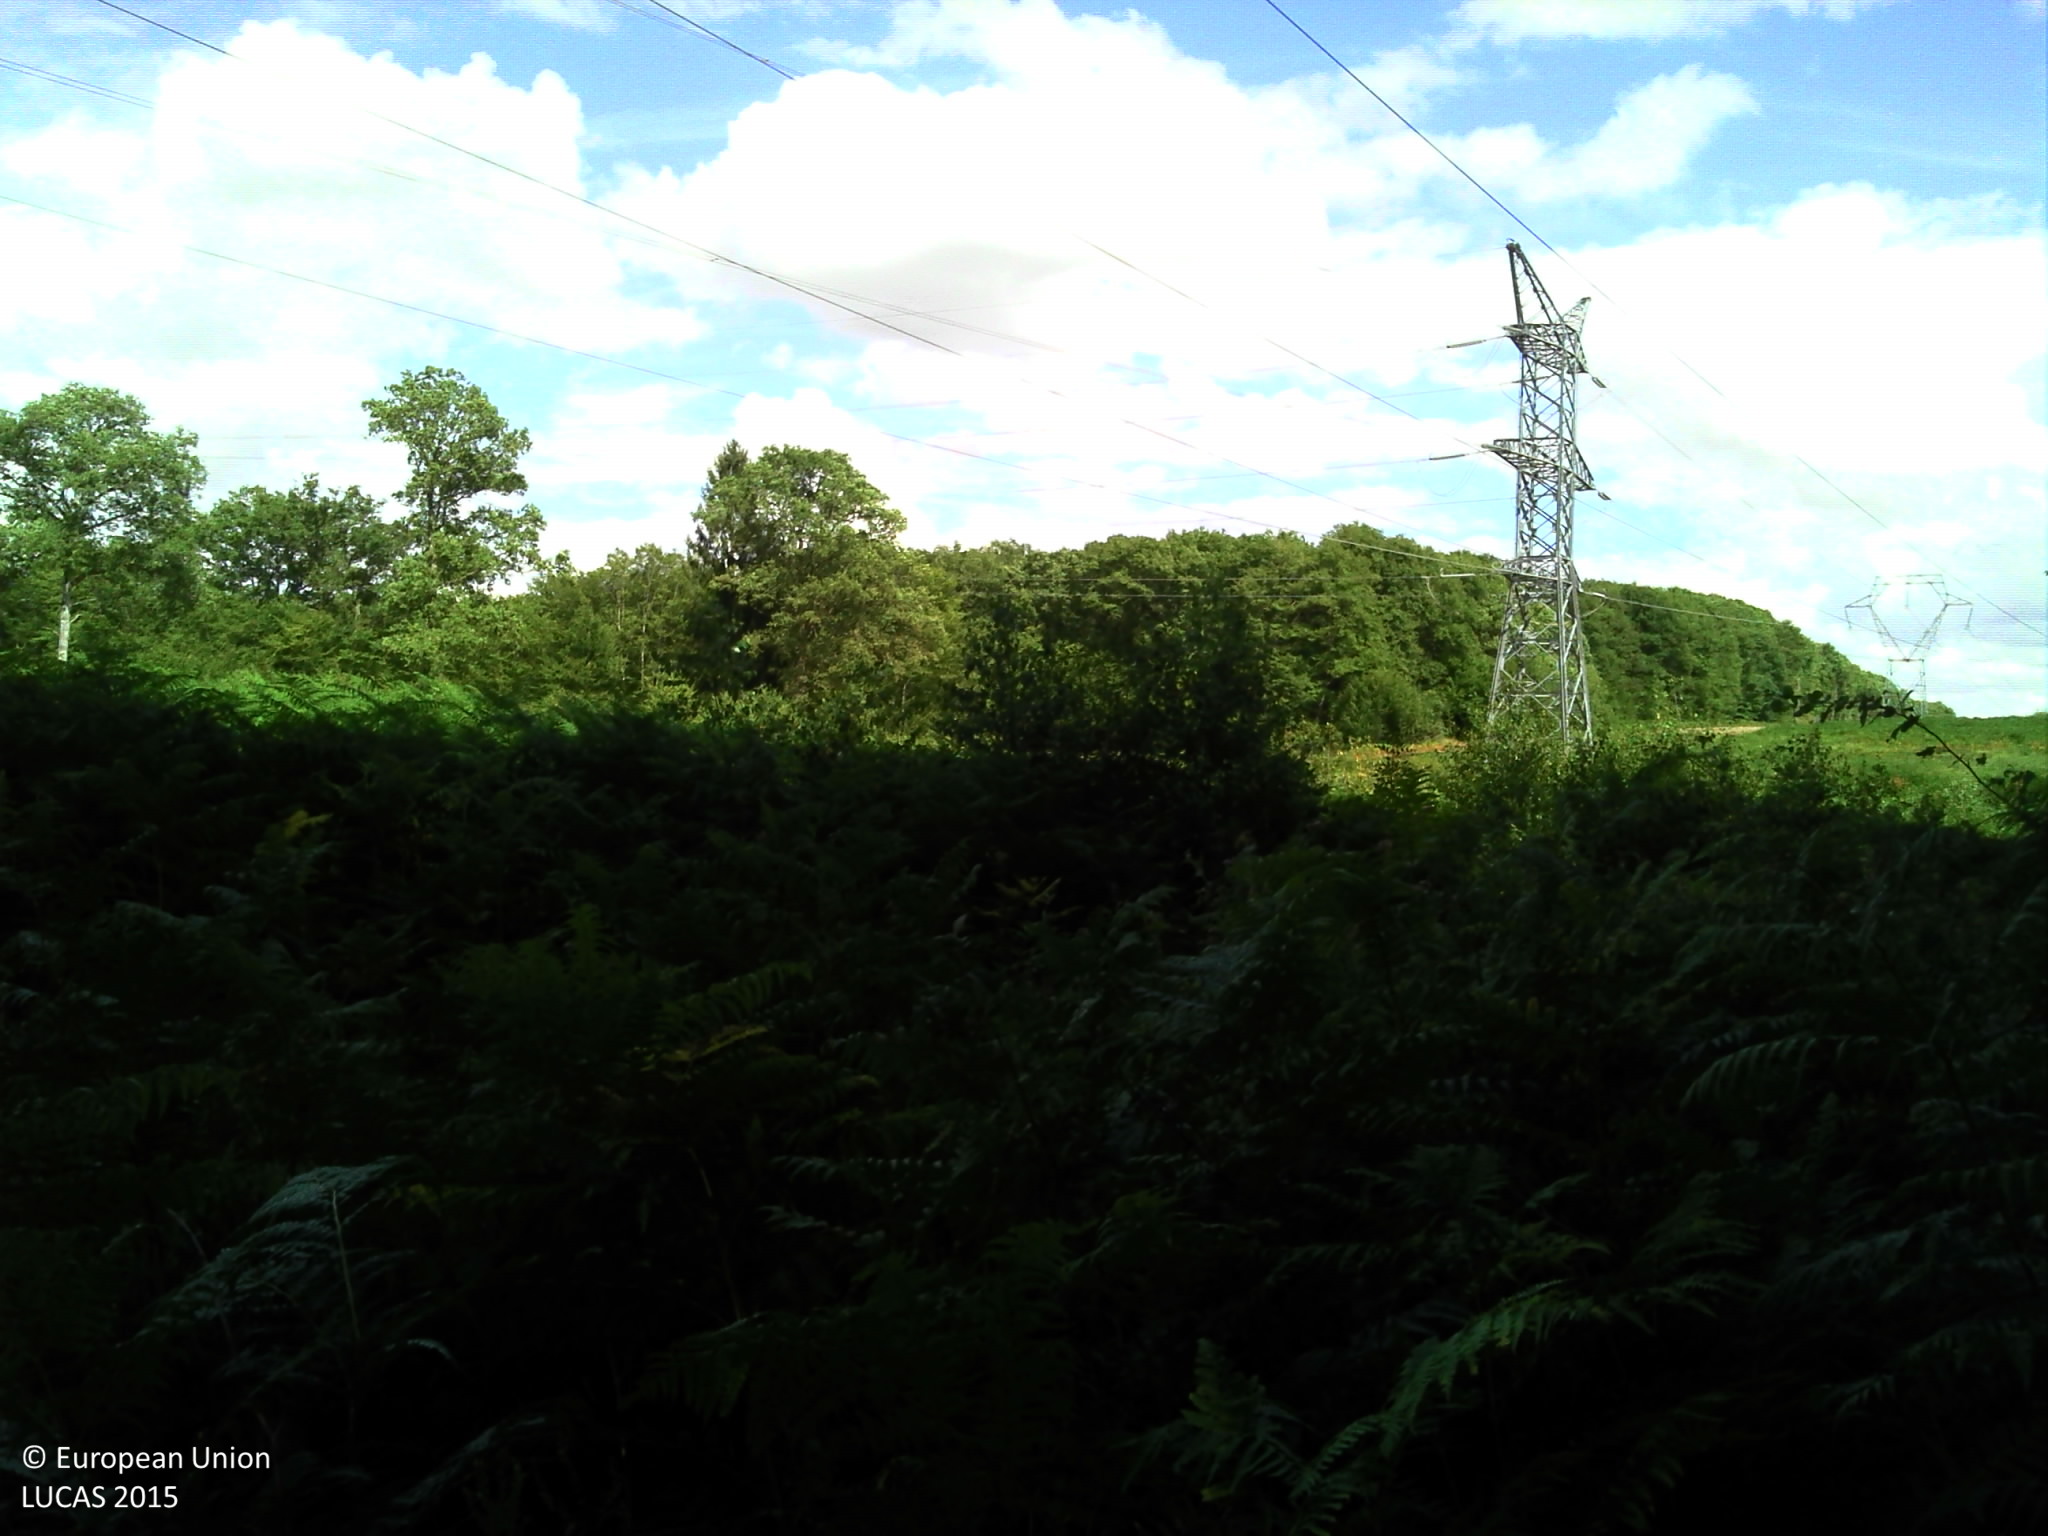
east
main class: Shrubland
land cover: Shrubland with sparse tree cover
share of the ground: > 75 %
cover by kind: herbaceous plants 80 %, shrubs 15 %, broadleaved forest trees 5 %
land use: Semi-natural and natural areas not in use
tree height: < 5 m
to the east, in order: Shrubland with sparse tree cover; Electric lines; Shrubland with sparse tree cover; Electric lines; Shrubland with sparse tree cover; Tracks; Other bare soil; Grass margins; Tracks; Grass margins; Broadleaved woodland; Shrubland with sparse tree cover; Electric lines; Shrubland with sparse tree cover; Broadleaved woodland
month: July
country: FR
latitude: 48.0279
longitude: 3.4373
